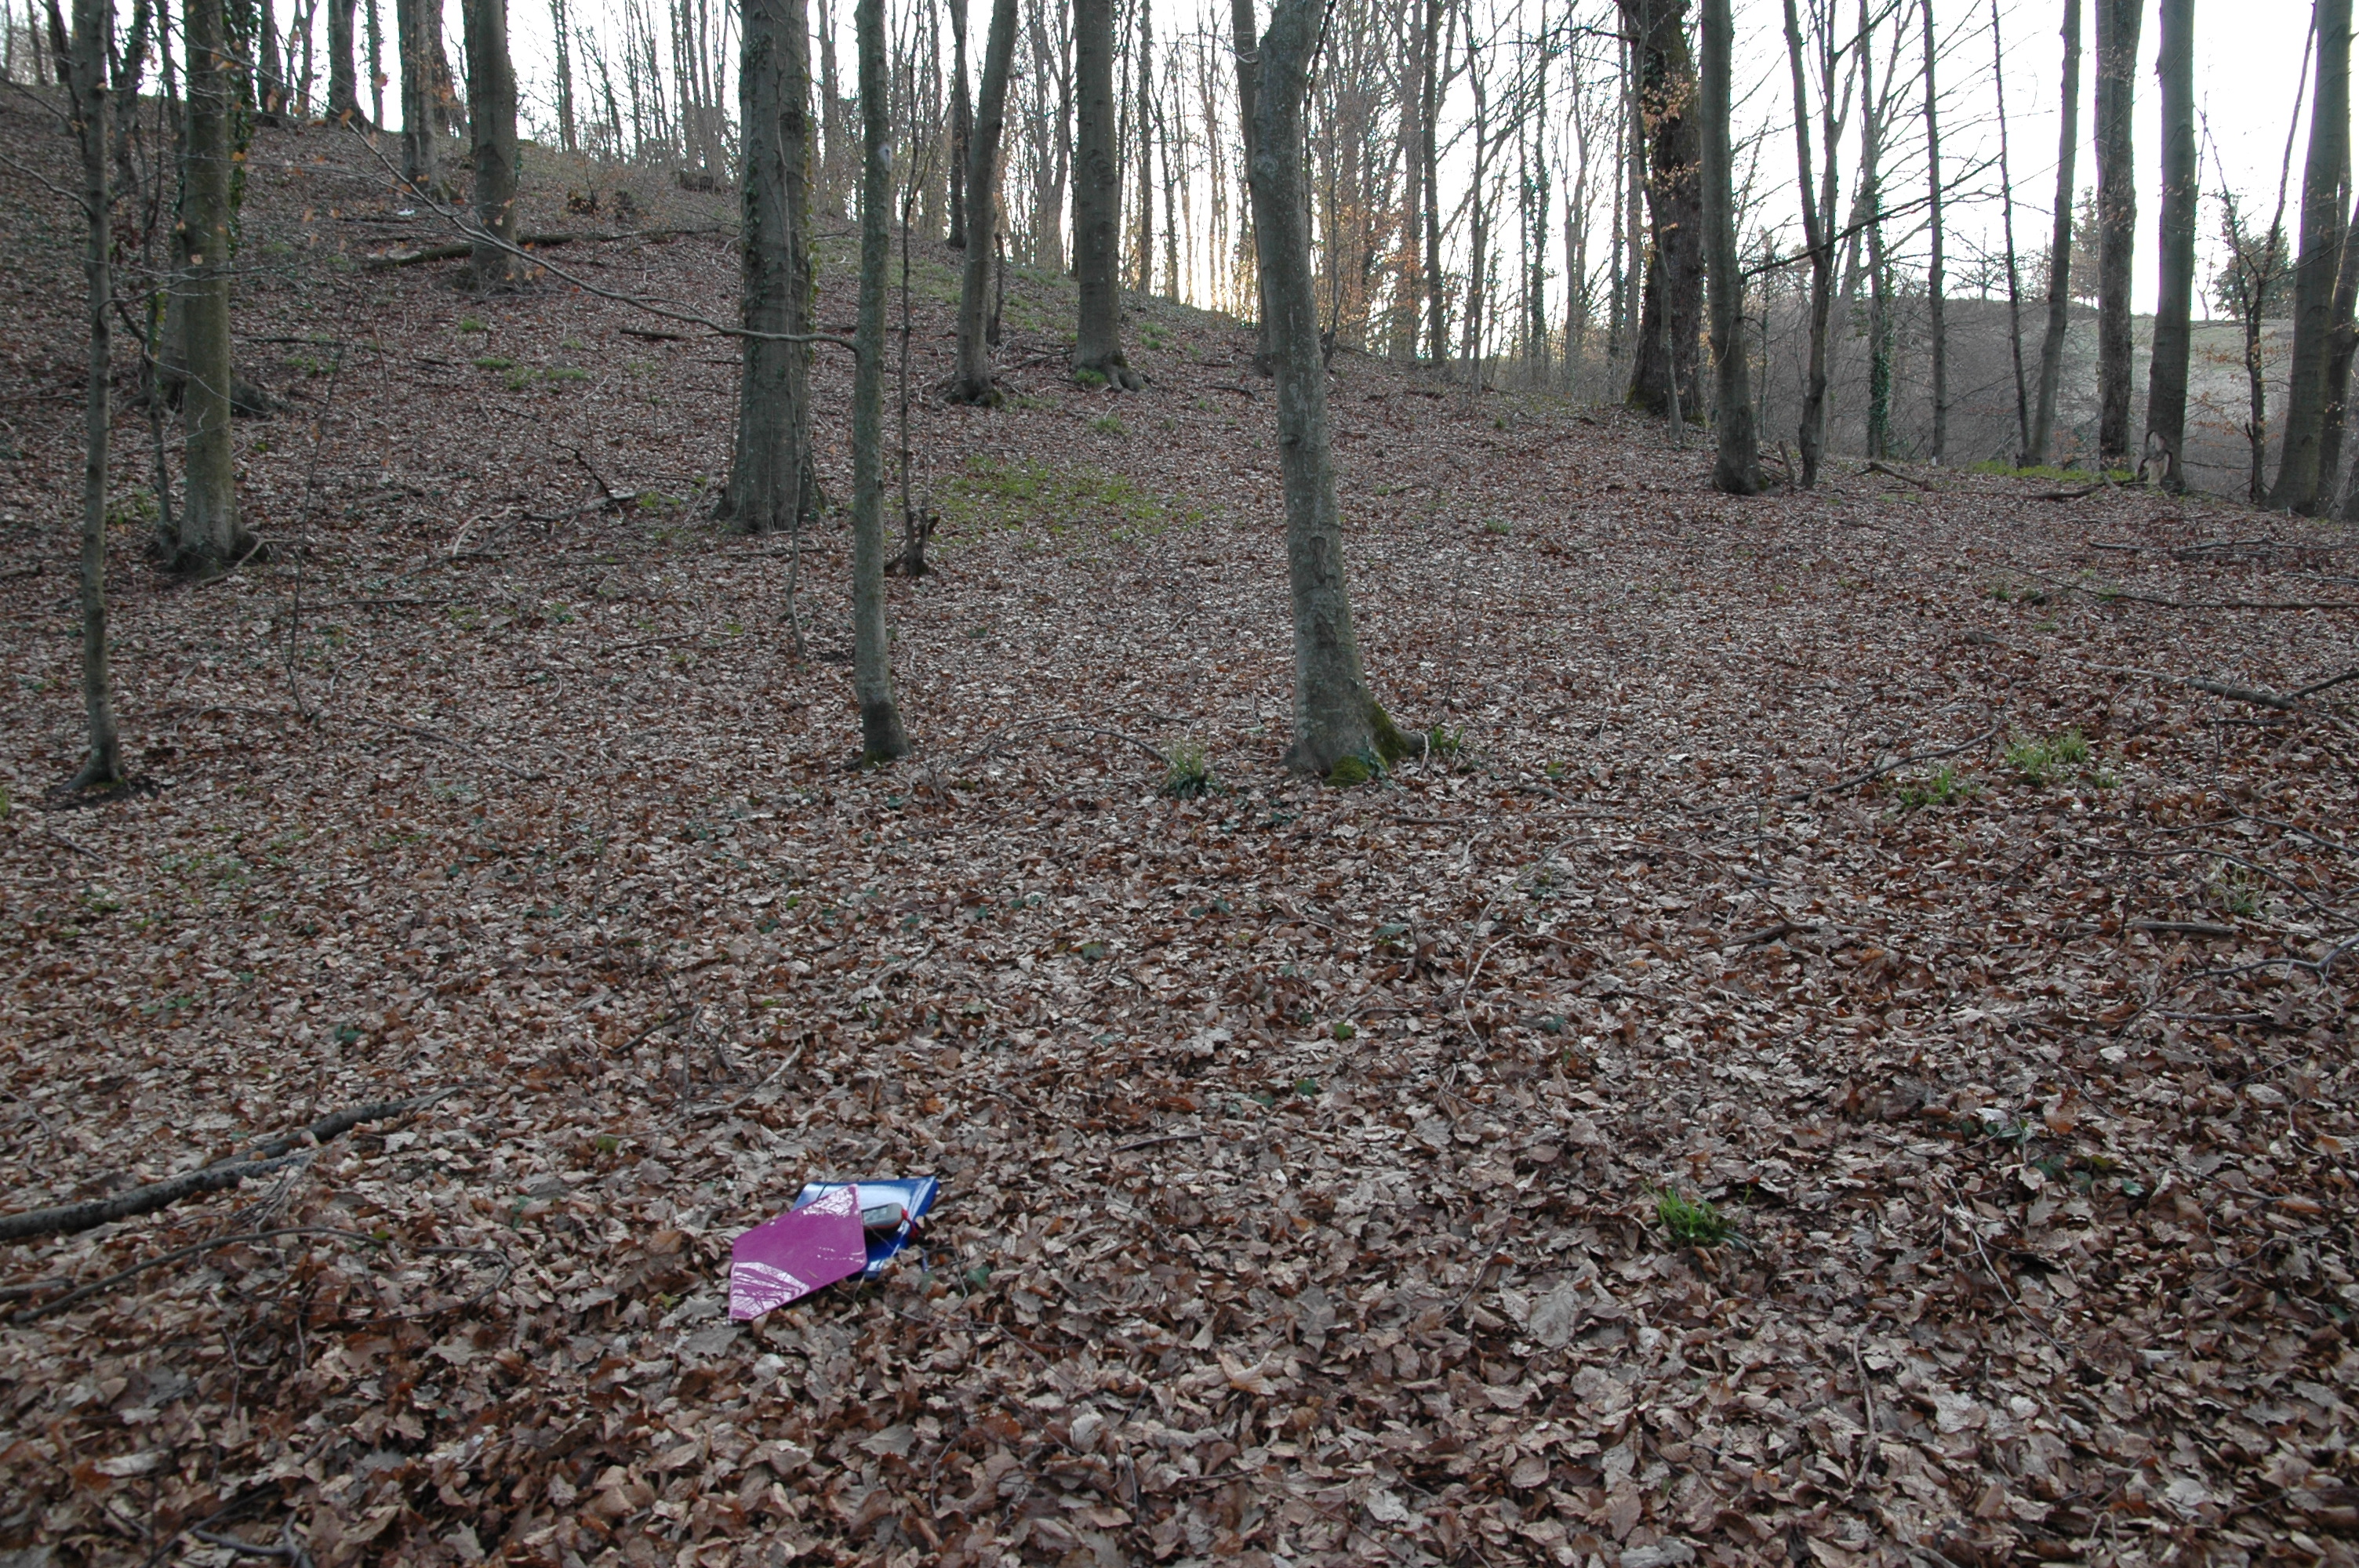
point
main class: Woodland
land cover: Broadleaved woodland
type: beech forest
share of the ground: > 75 %
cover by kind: broadleaved forest trees 90 %, shrubs 5 %, herbaceous plants 5 %
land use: Forestry
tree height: > 5 m
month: March
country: HR
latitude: 46.2397
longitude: 15.9515
